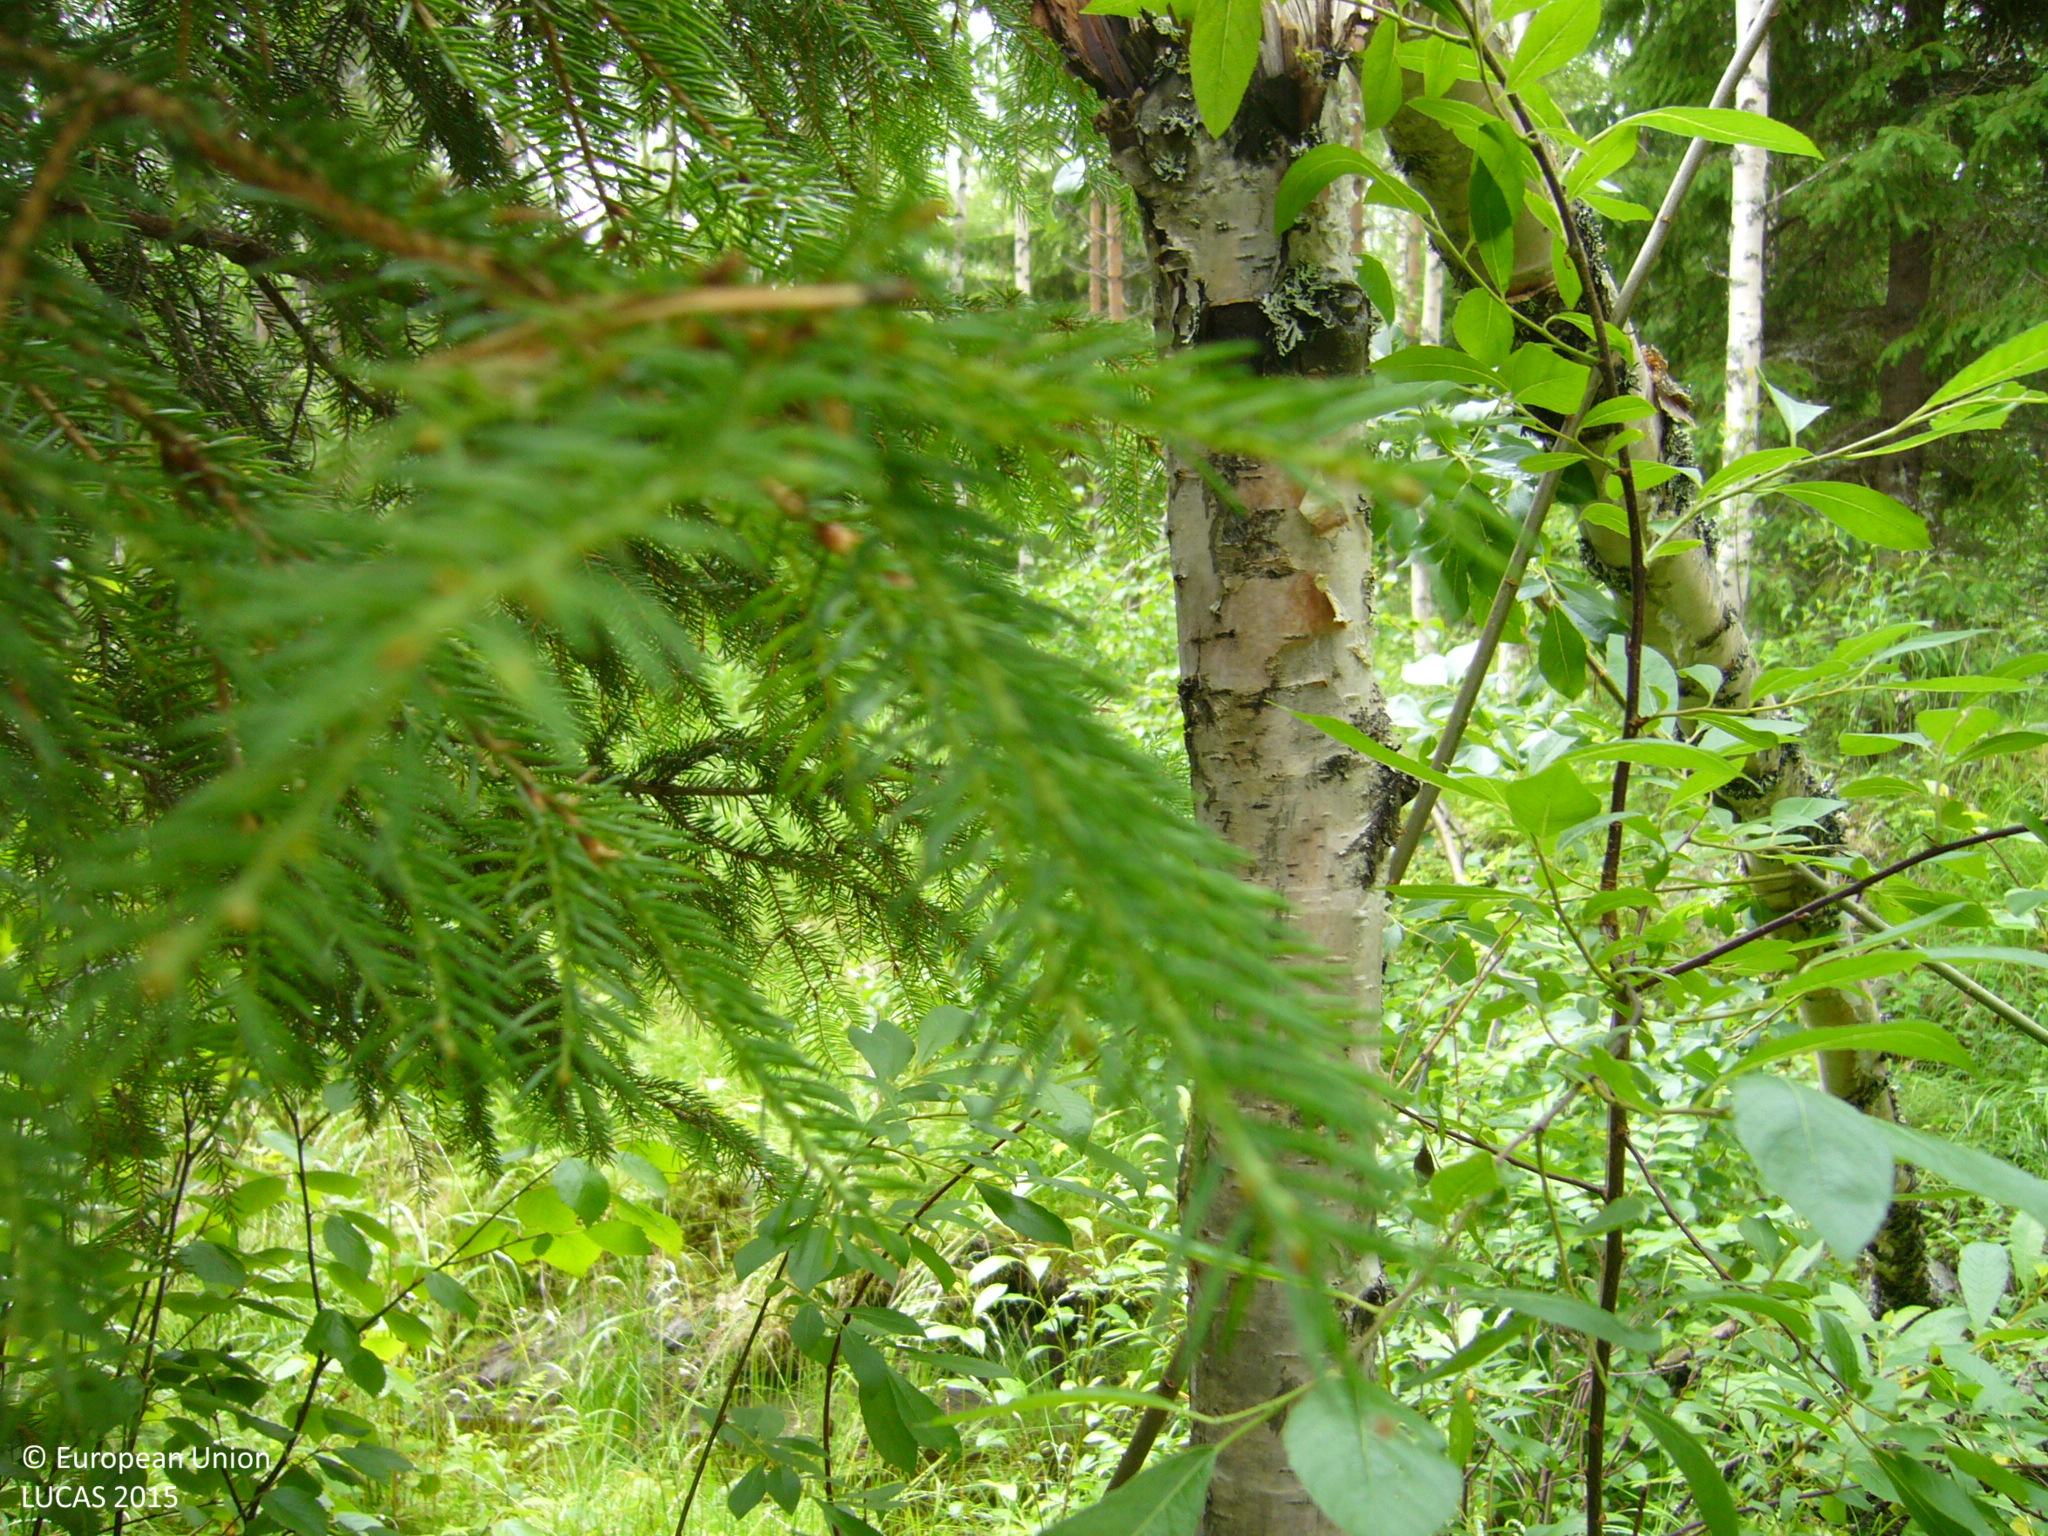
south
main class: Woodland
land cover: Pine dominated mixed woodland
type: boreal forest
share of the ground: > 75 %
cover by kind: coniferous forest trees 50 %, broadleaved forest trees 25 %, shrubs 25 %
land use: Forestry
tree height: > 5 m
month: July
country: FI
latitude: 63.4101
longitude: 25.2966
